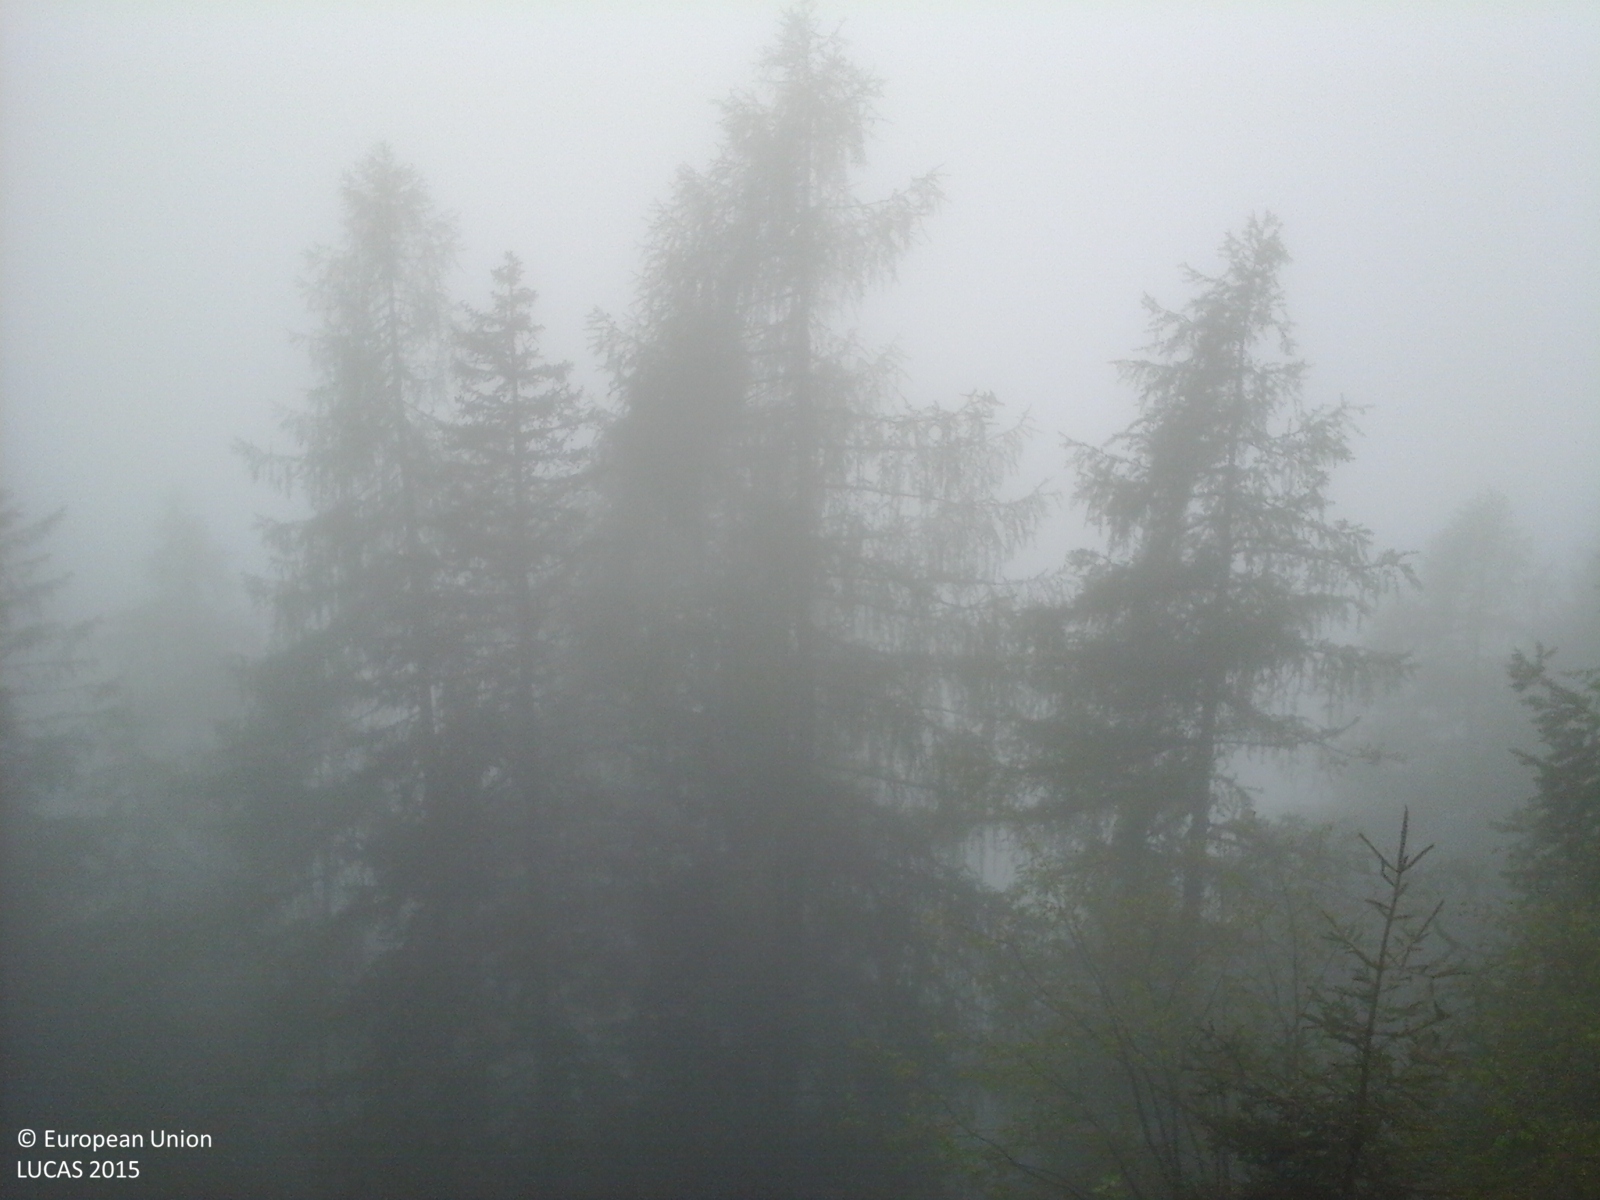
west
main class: Woodland
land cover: Other coniferous woodland
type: alpine coniferous forest
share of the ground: > 75 %
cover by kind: coniferous forest trees 80 %, herbaceous plants 20 %
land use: Forestry
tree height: > 5 m
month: May
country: IT
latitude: 46.1044
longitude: 11.6407
